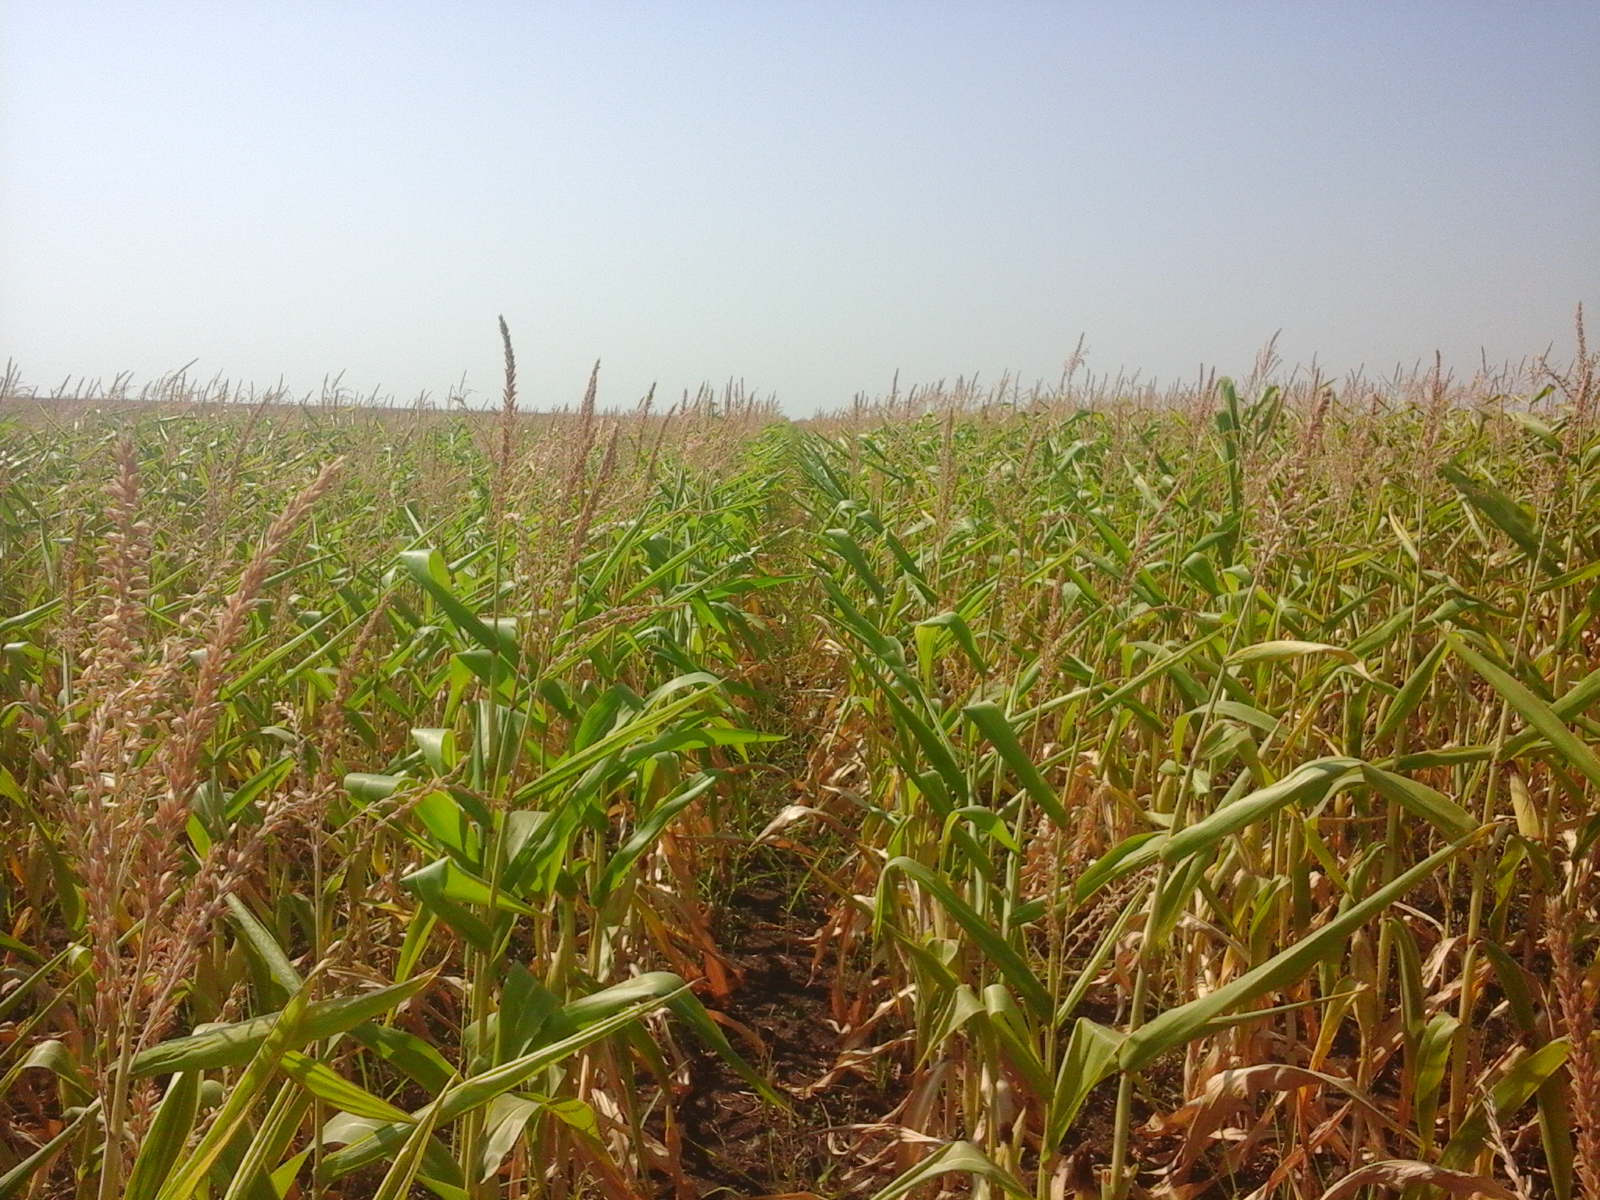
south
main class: Cropland
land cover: Maize
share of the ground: > 75 %
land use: Agriculture (excluding fallow land and kitchen gardens)
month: August
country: RO
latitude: 45.7557
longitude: 27.6313
